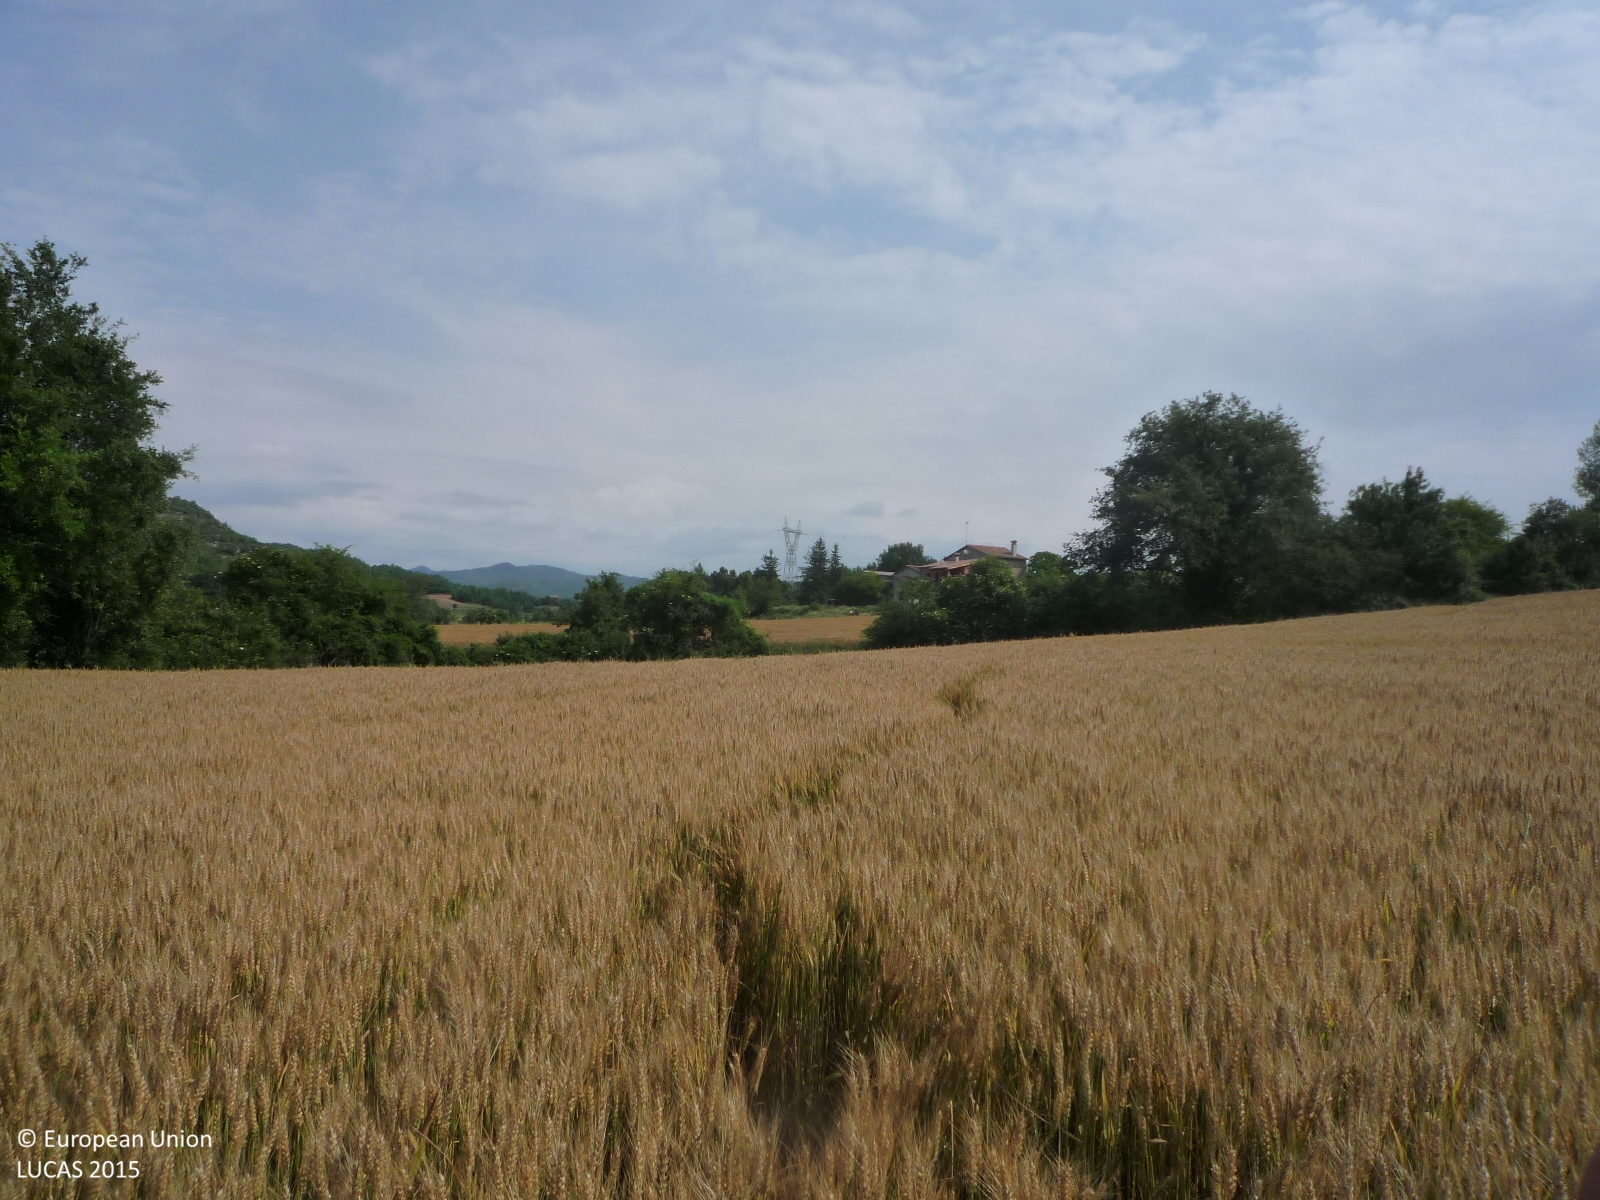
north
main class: Cropland
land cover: Durum wheat
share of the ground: > 75 %
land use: Agriculture (excluding fallow land and kitchen gardens)
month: June
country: ES
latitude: 42.0094
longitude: 1.9842
